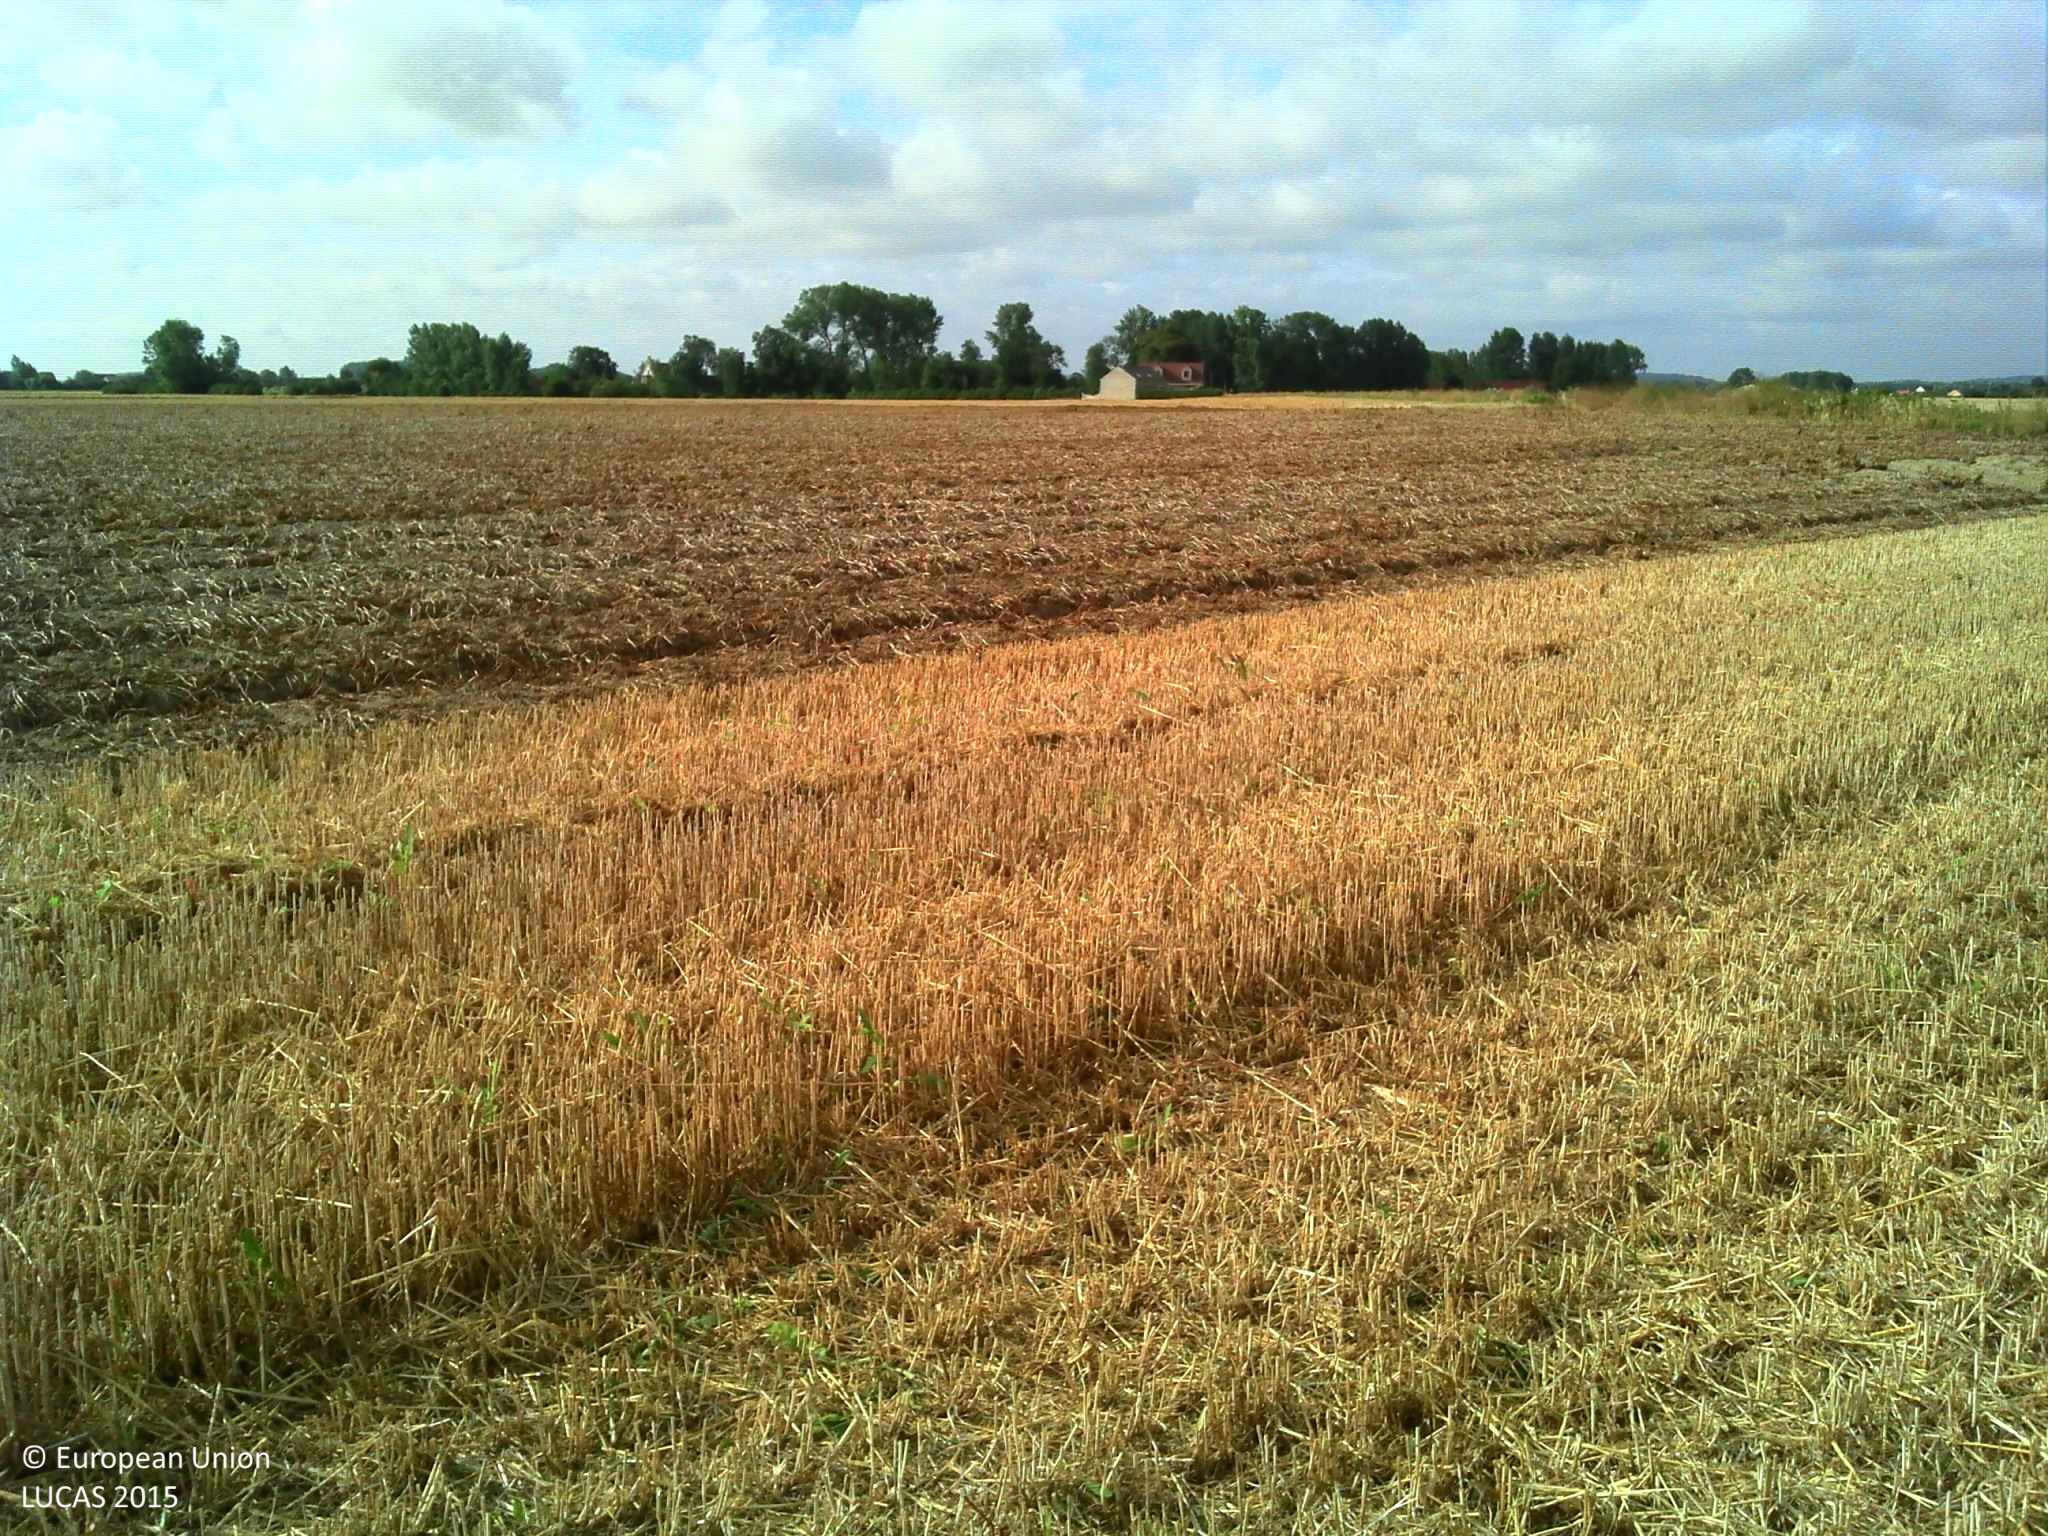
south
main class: Cropland
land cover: Common wheat
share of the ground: 50 - 75 %
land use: Agriculture (excluding fallow land and kitchen gardens)
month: August
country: FR
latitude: 50.8655
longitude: 2.0704
